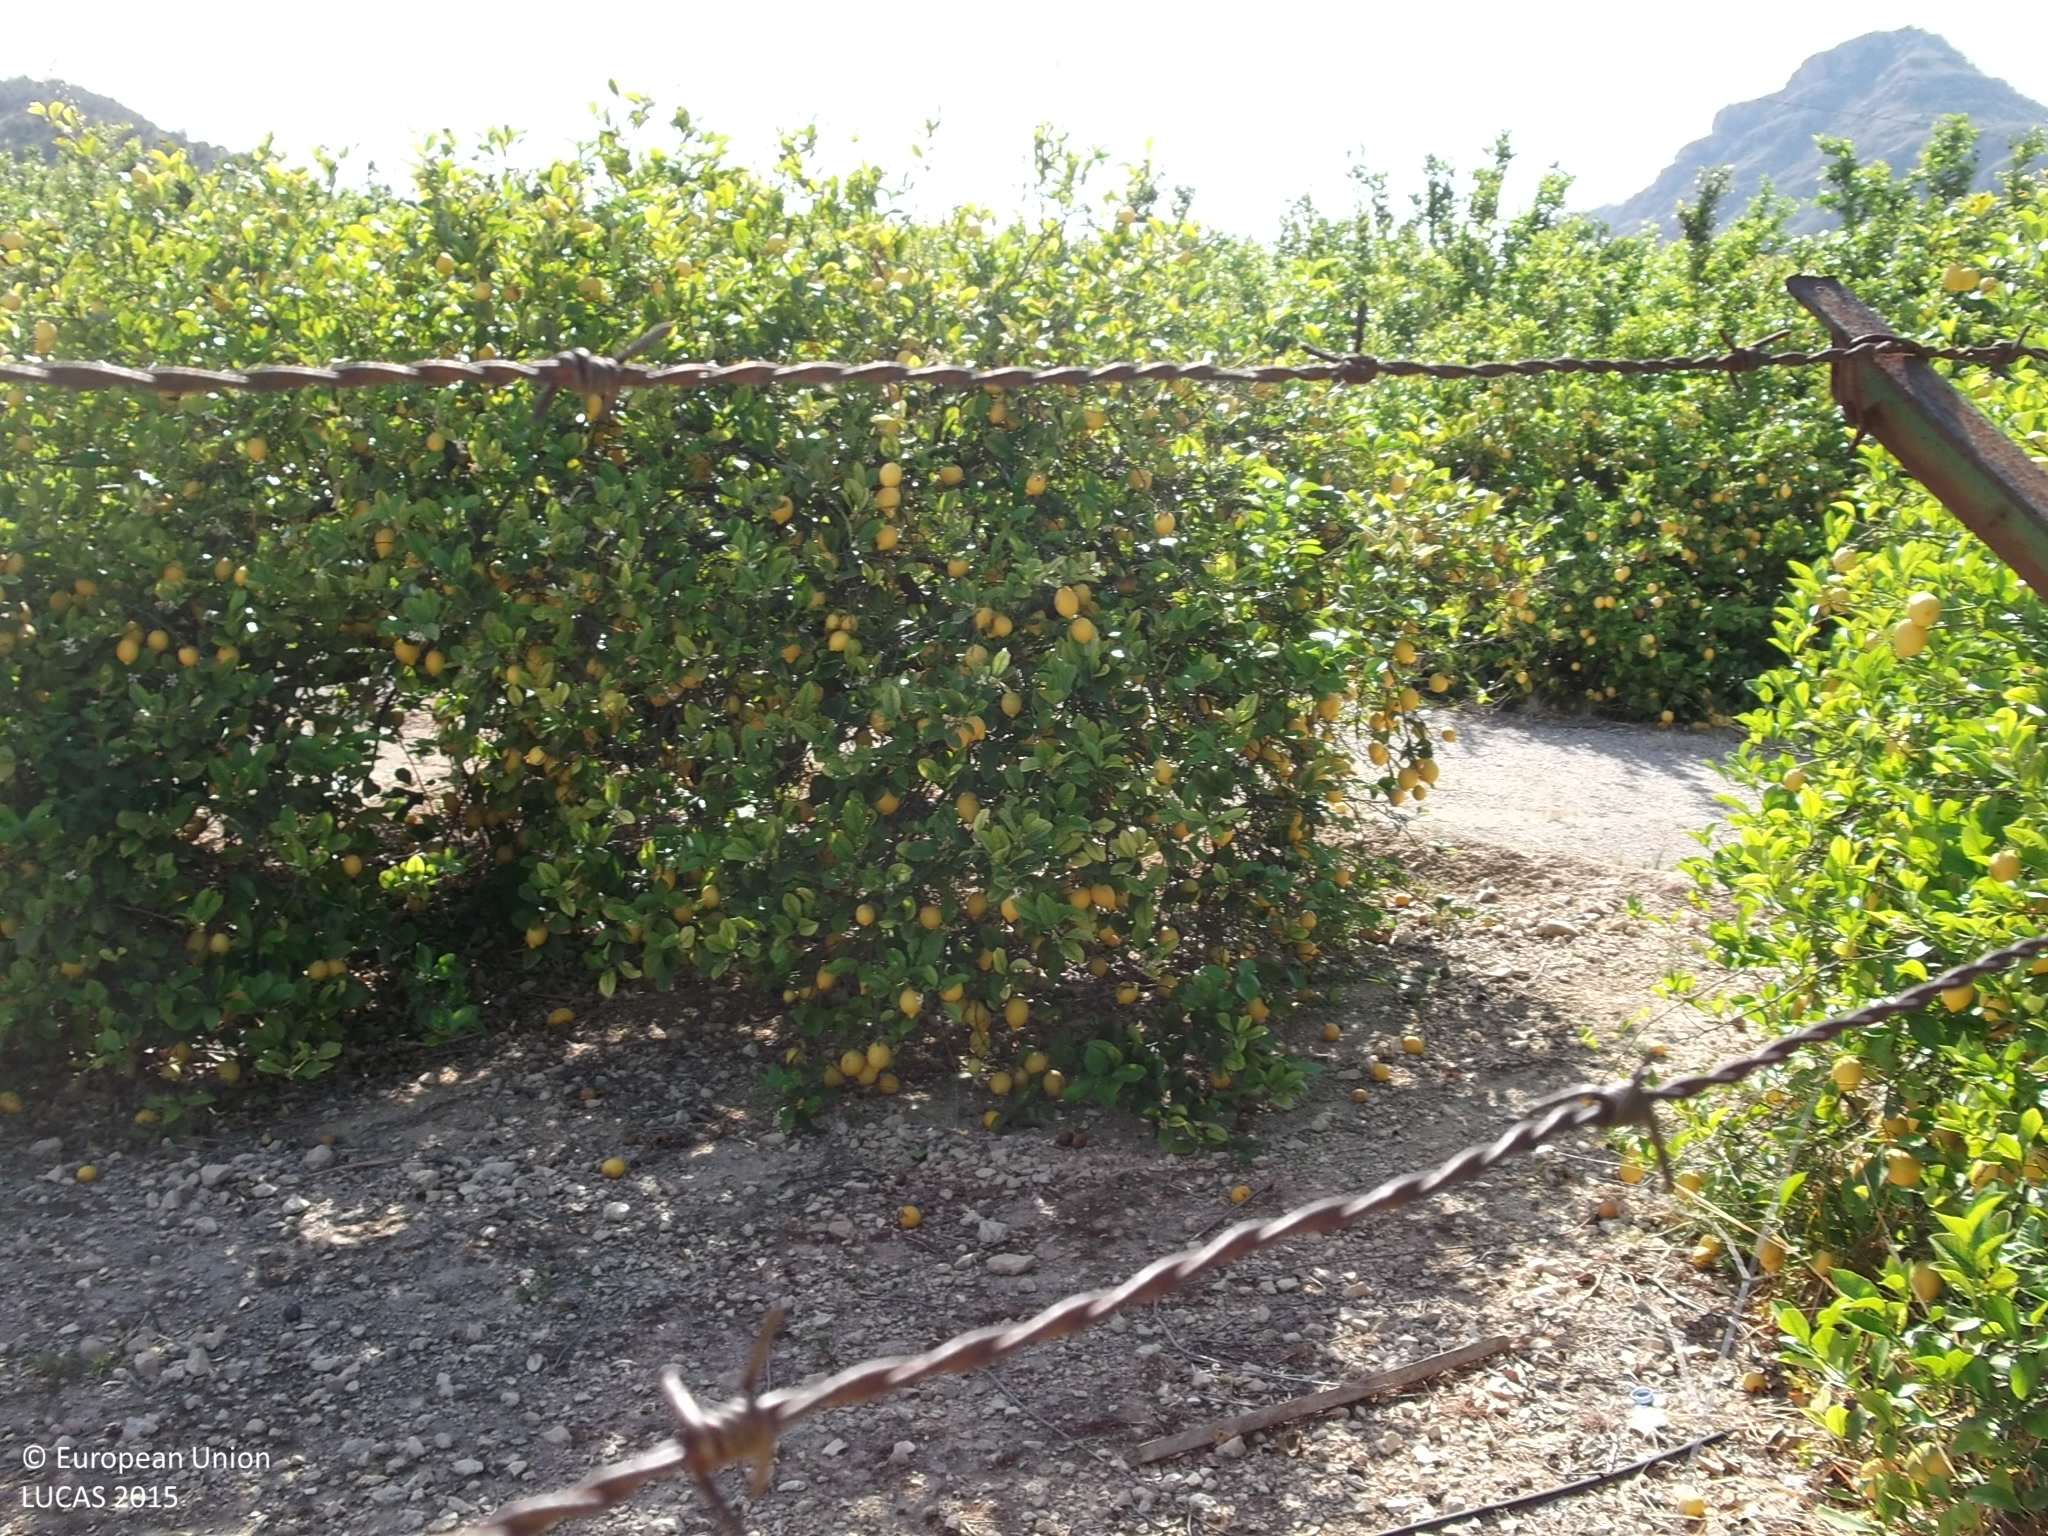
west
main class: Cropland
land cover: Other citrus fruit
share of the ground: 25 - 50 %
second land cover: Spontaneously vegetated surfaces
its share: > 75 %
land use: Agriculture (excluding fallow land and kitchen gardens)
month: April
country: ES
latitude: 38.1846
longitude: -1.3240
